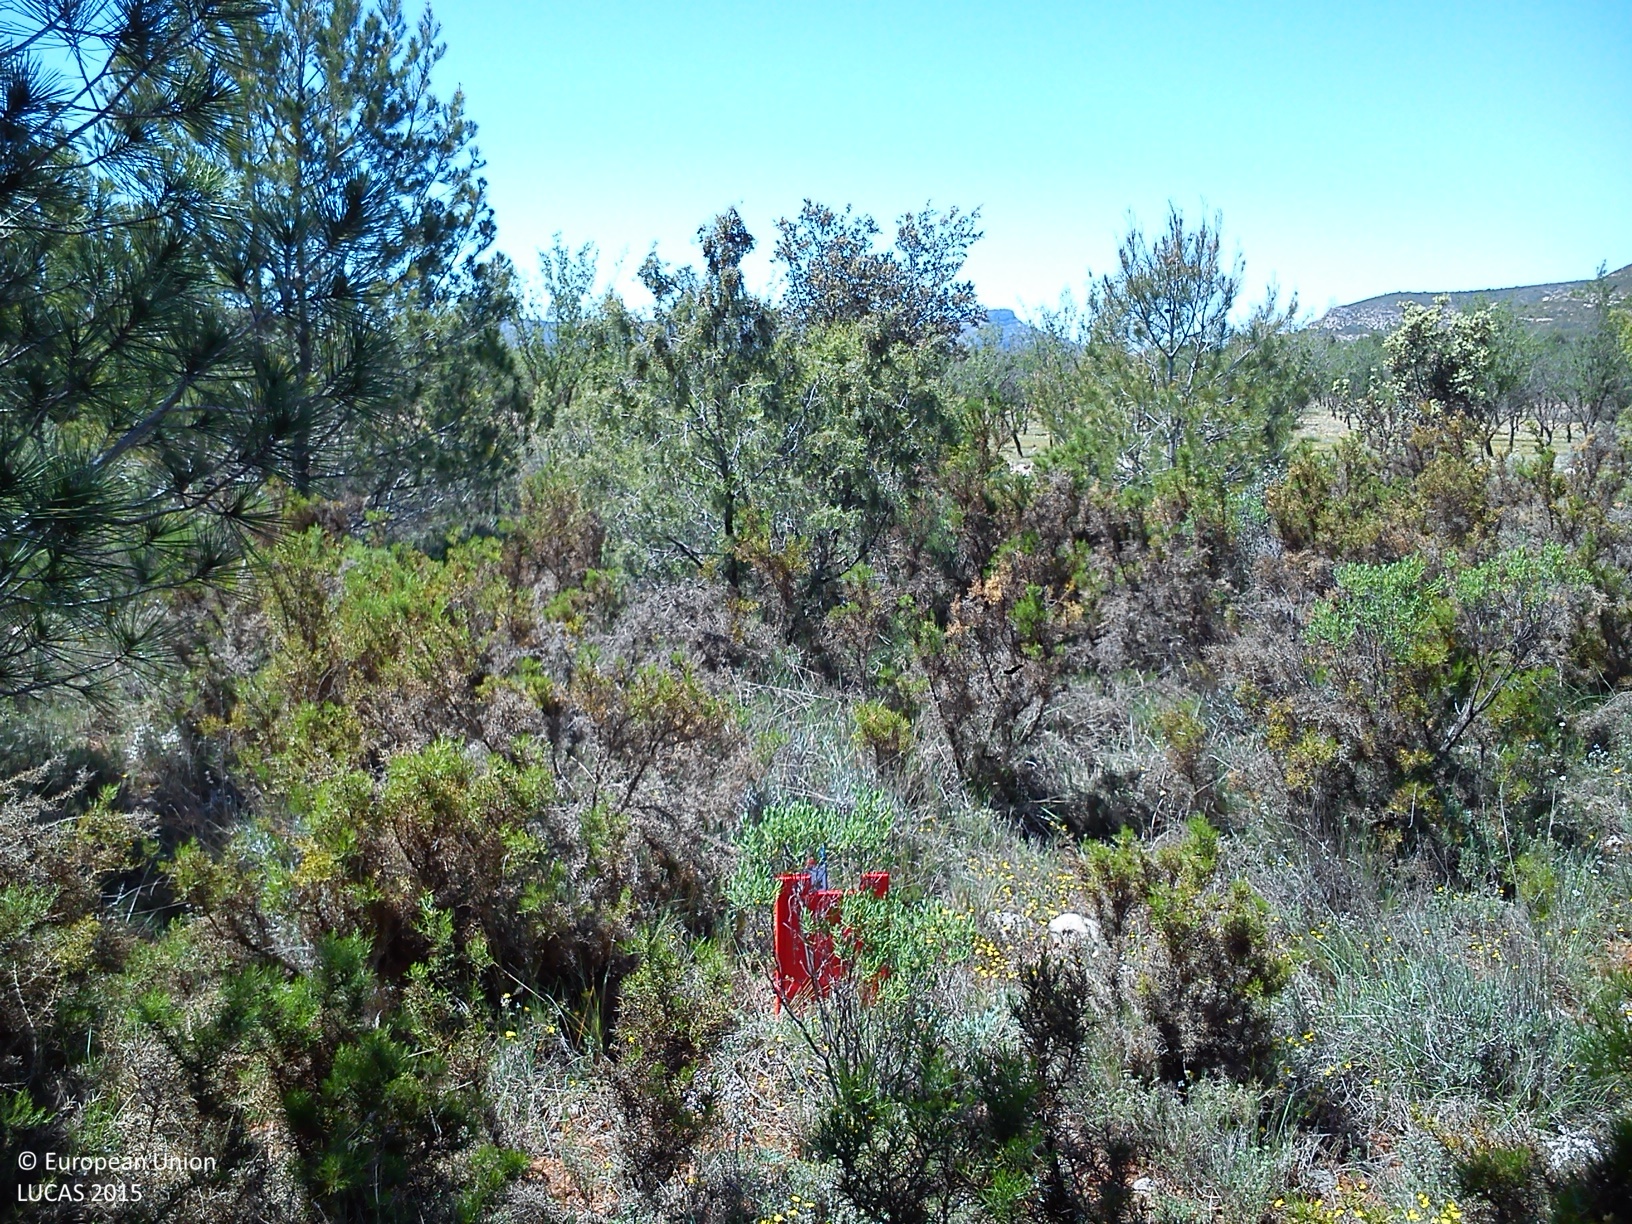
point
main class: Woodland
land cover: Pine dominated coniferous woodland
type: coniferous forest of the mediterranean region
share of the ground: > 75 %
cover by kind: shrubs 55 %, coniferous forest trees 35 %, herbaceous plants 10 %
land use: Semi-natural and natural areas not in use
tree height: > 5 m
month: May
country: ES
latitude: 39.5660
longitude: -0.9077
